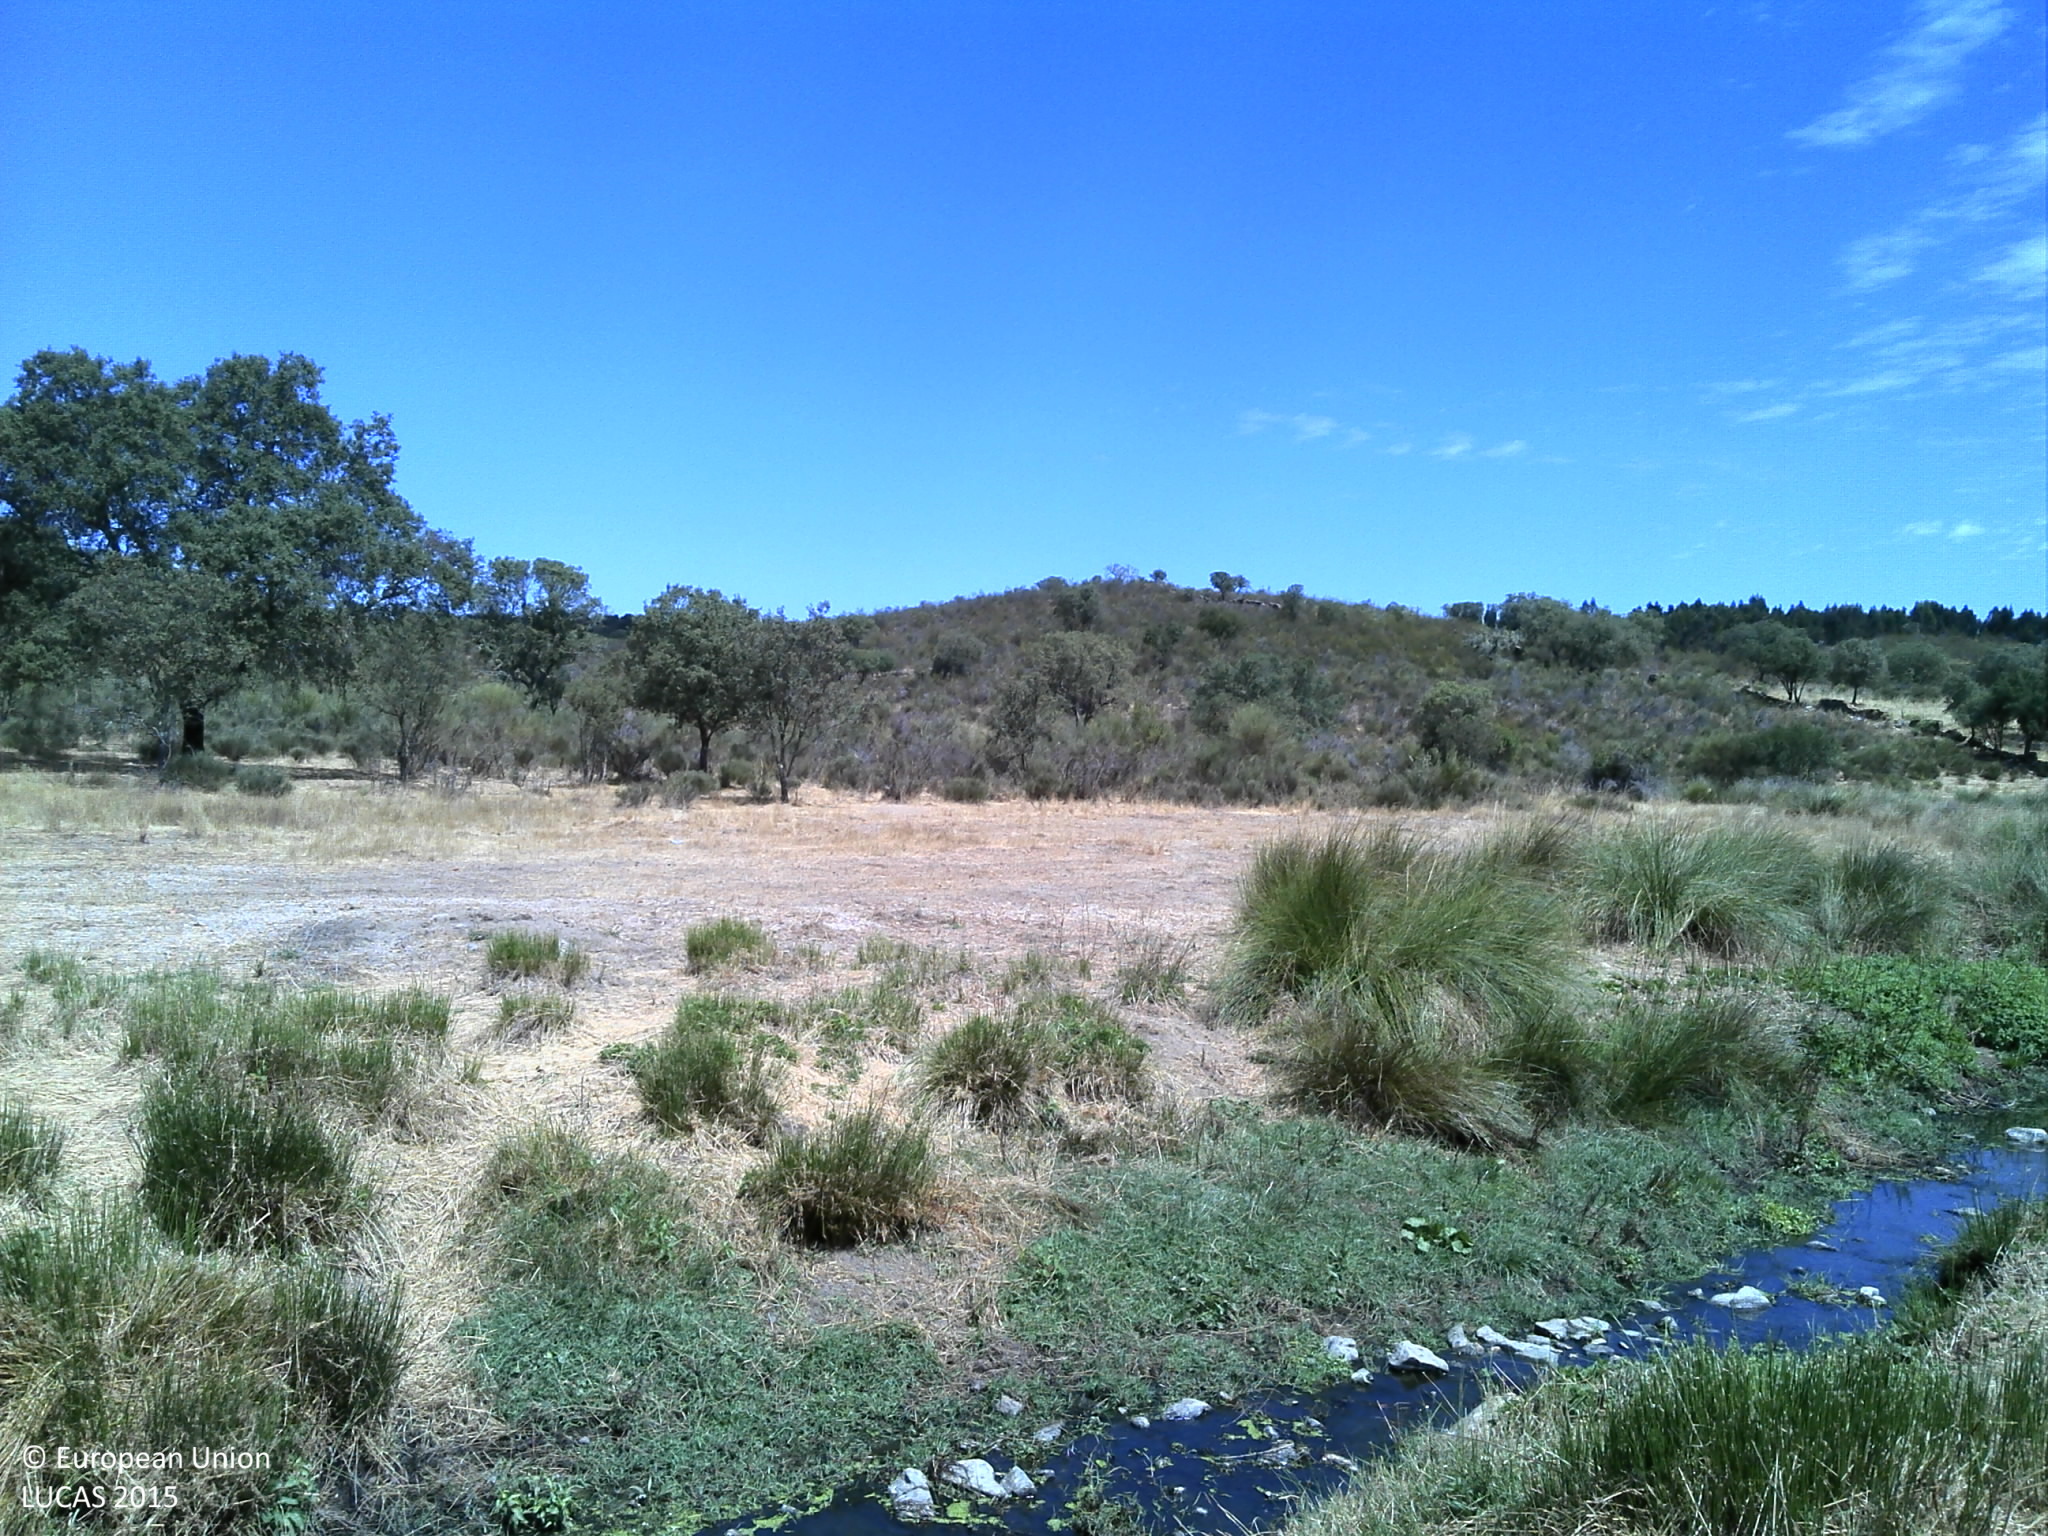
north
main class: Grassland
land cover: Grassland without tree/shrub cover
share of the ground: > 75 %
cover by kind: herbaceous plants 75 %, unconsolidated bare surface 25 %
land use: Agriculture (excluding fallow land and kitchen gardens)
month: August
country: PT
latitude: 39.5249
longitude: -7.6279
